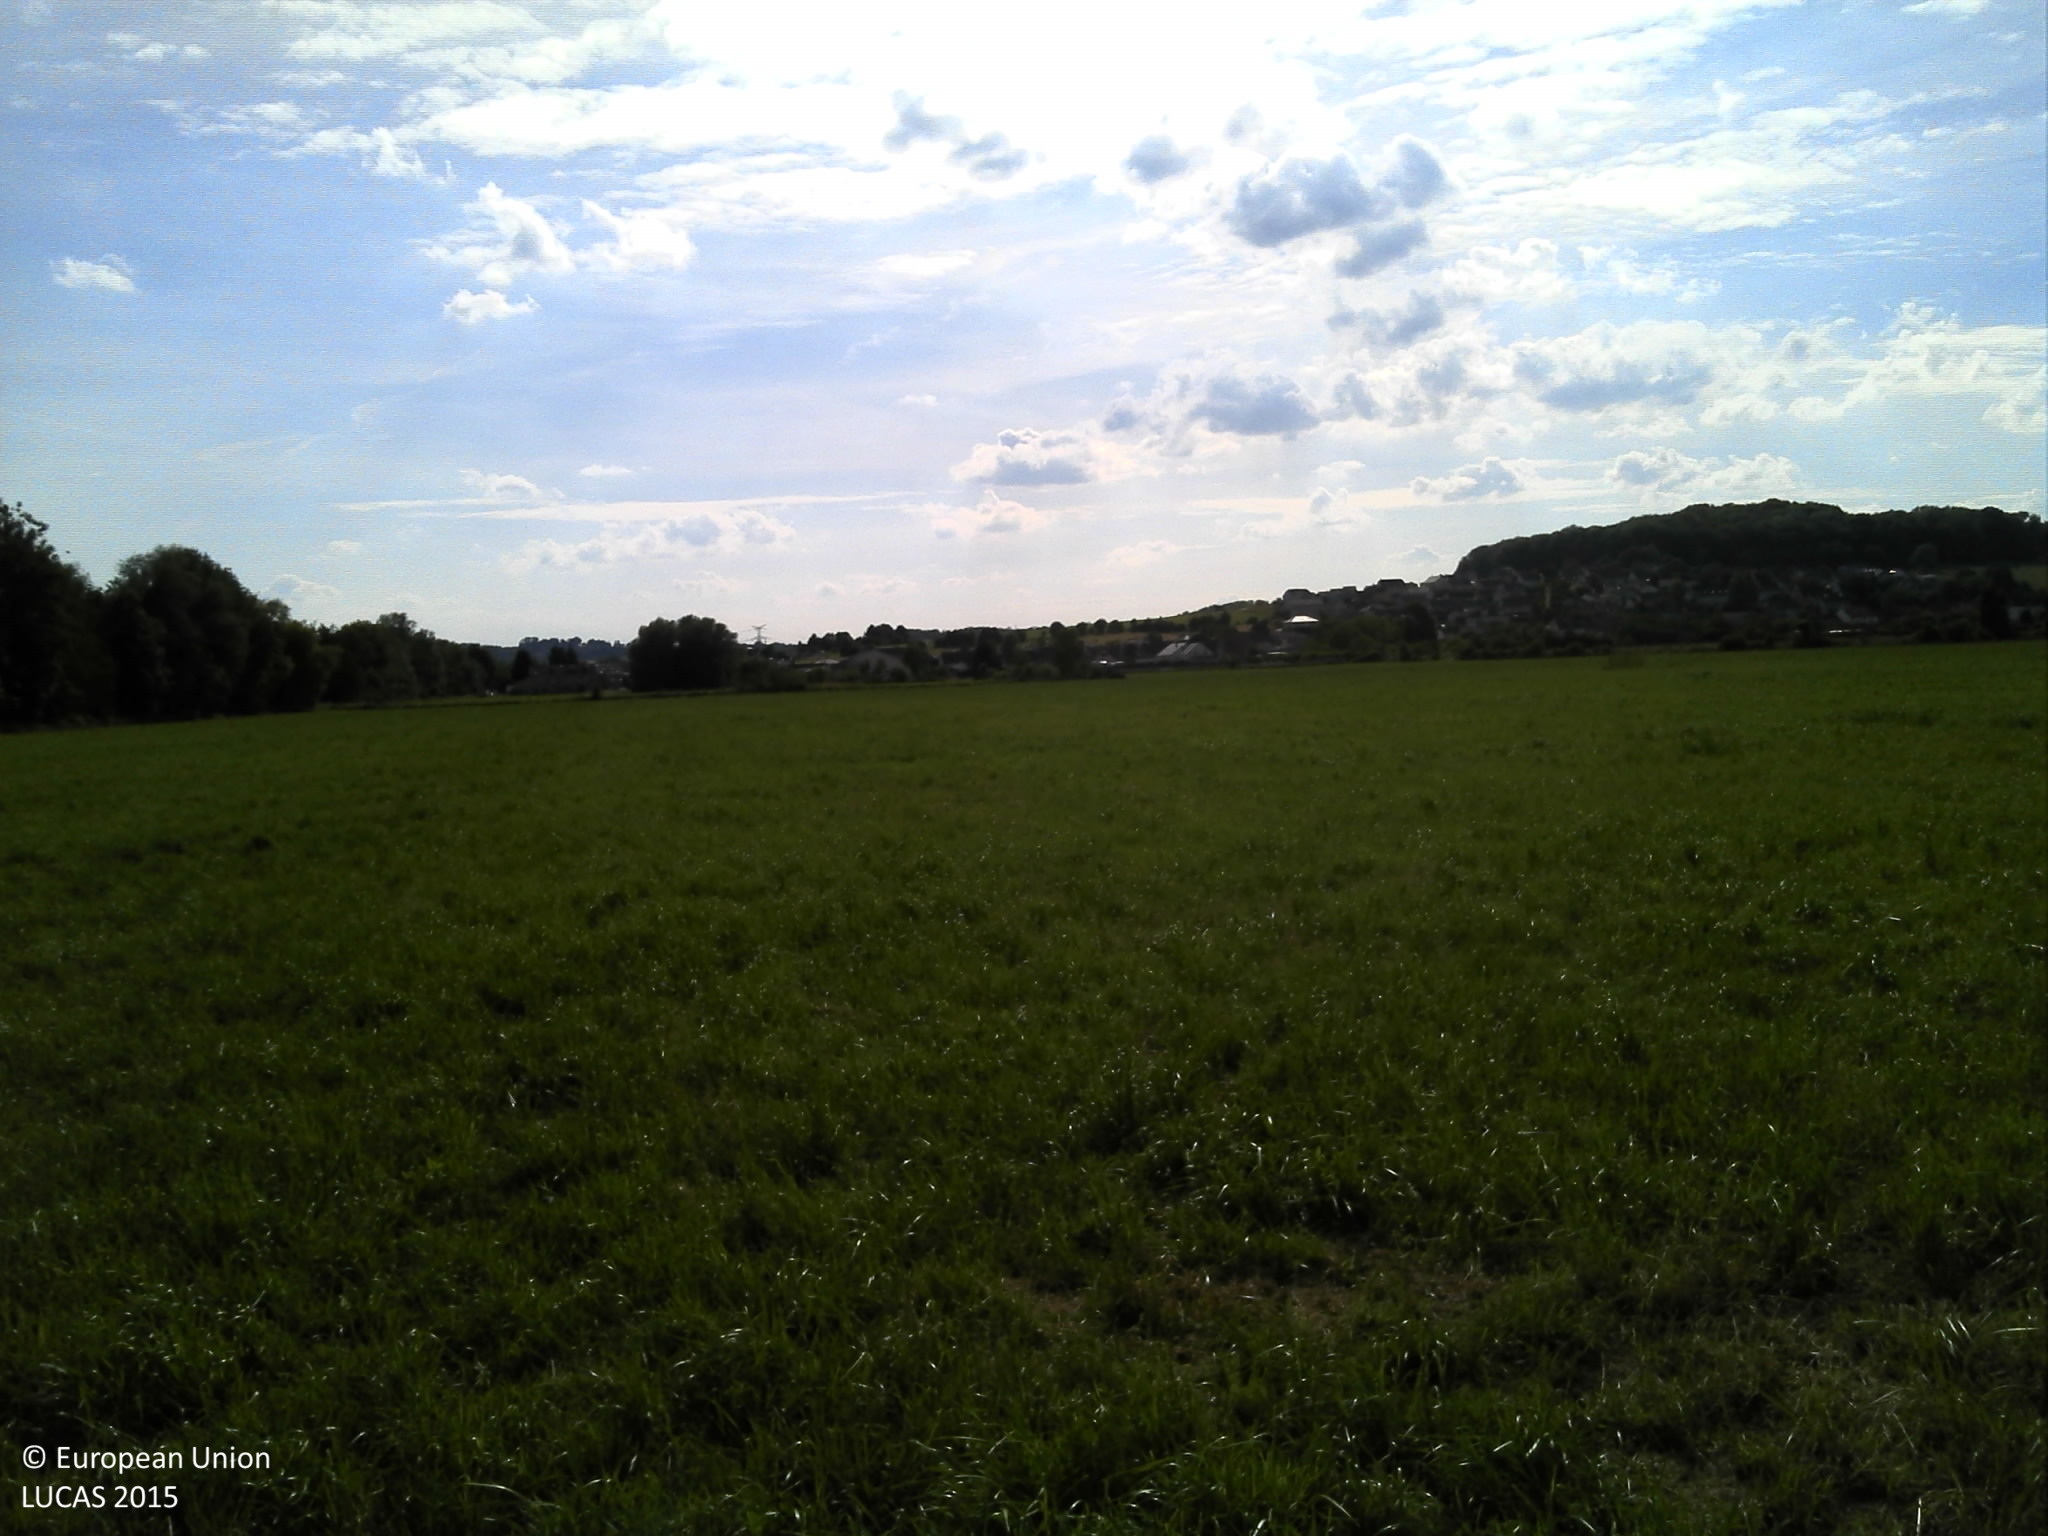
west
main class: Grassland
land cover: Grassland without tree/shrub cover
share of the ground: > 75 %
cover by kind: herbaceous plants 100 %
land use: Agriculture (excluding fallow land and kitchen gardens)
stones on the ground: < 10 %
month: June
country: FR
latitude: 49.7218
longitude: 4.7675
